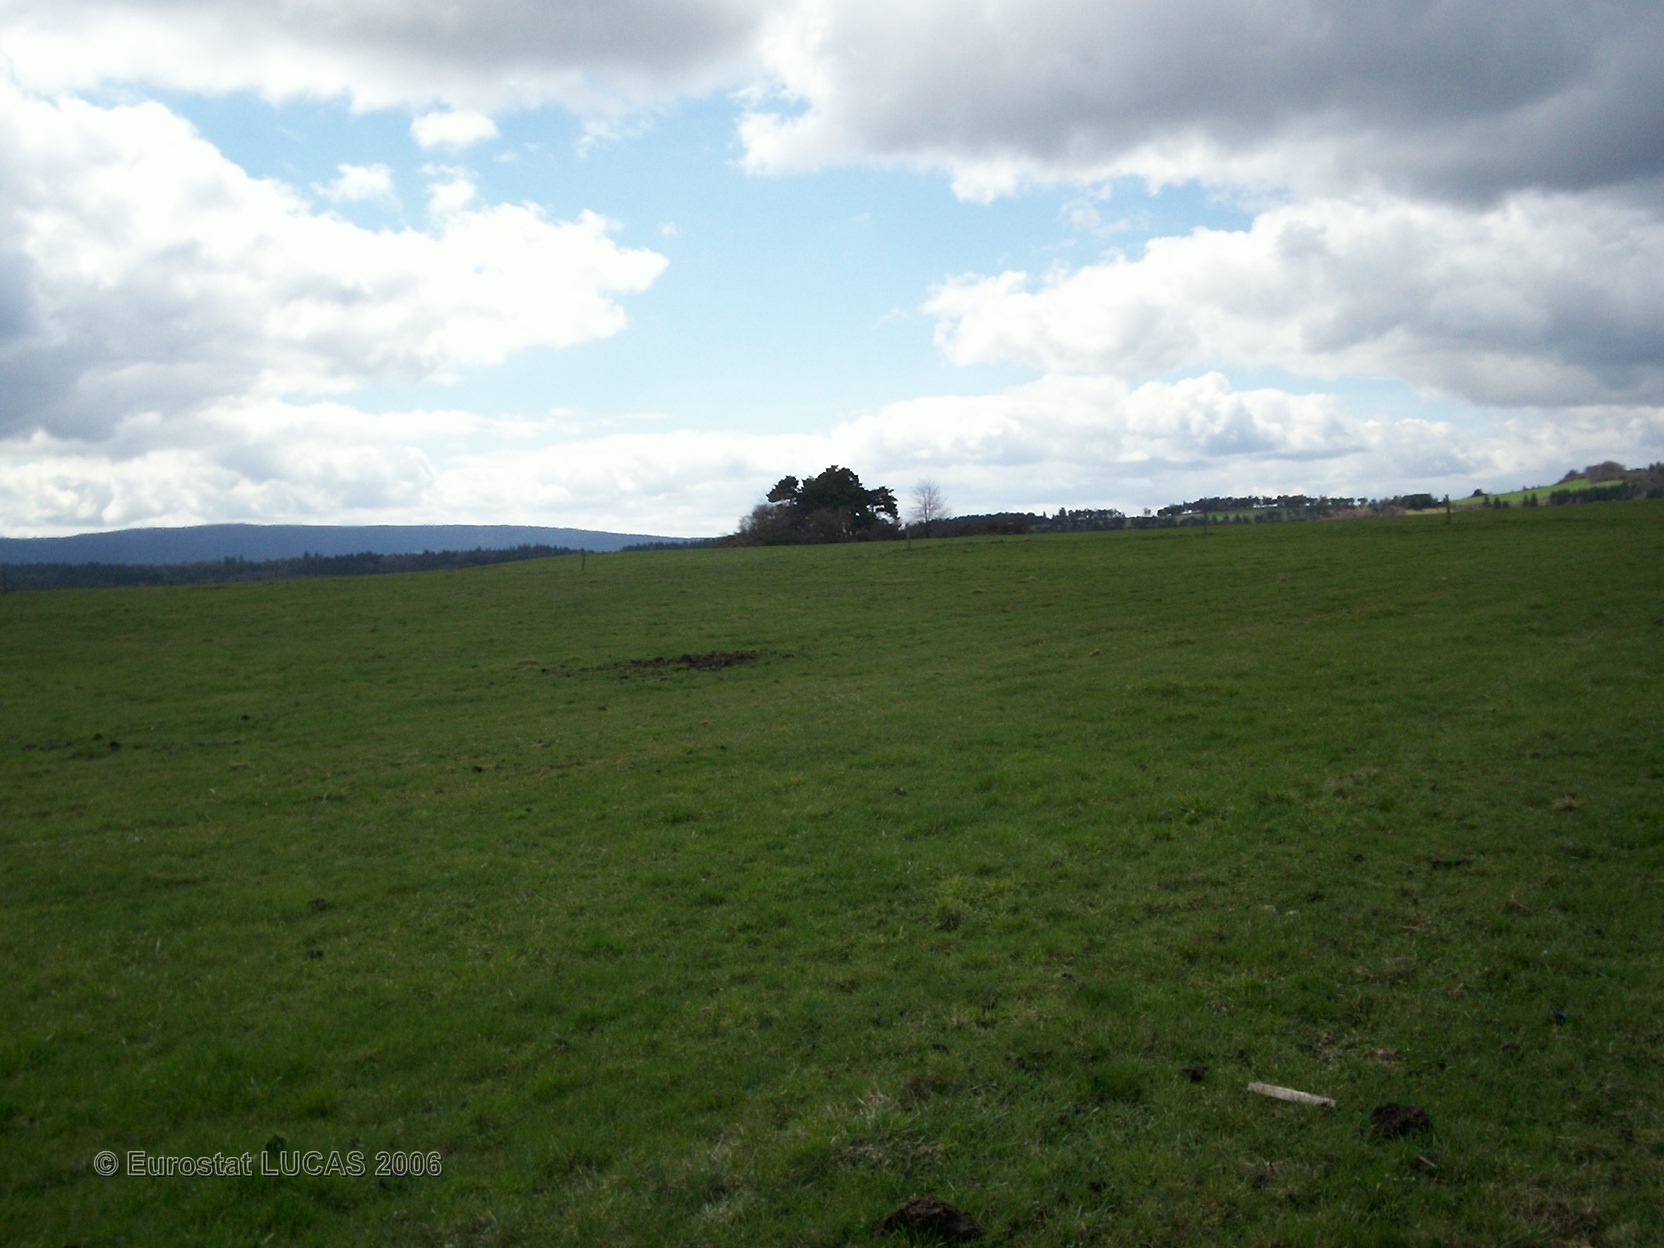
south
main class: Grassland
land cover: Grassland without tree/shrub cover
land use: Agriculture (excluding fallow land and kitchen gardens)
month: April
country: FR
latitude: 45.1077
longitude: 3.2536
